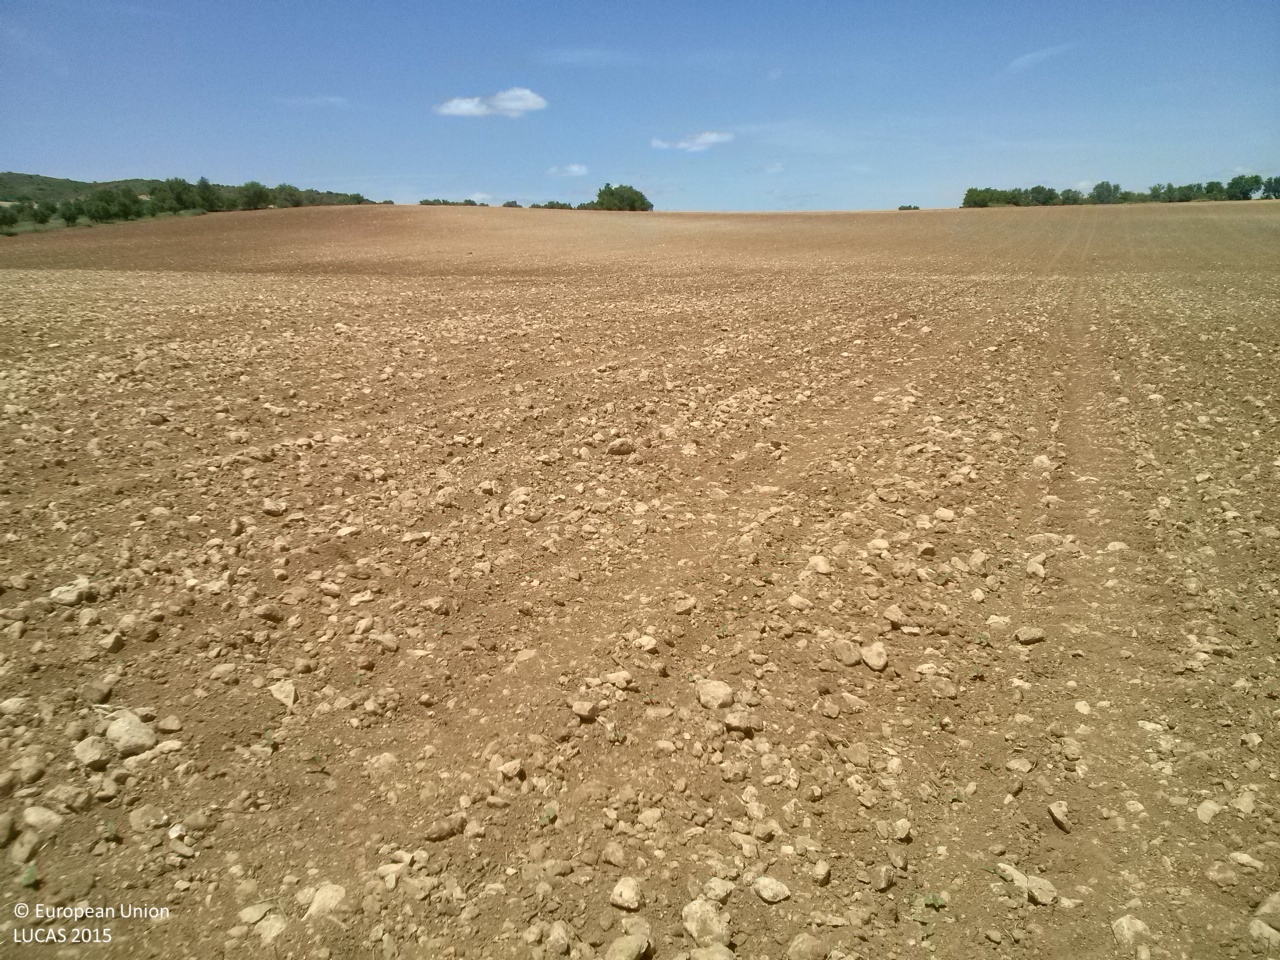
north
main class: Cropland
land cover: Sunflower
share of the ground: < 10 %
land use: Agriculture (excluding fallow land and kitchen gardens)
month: May
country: ES
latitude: 40.0993
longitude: -2.8206
